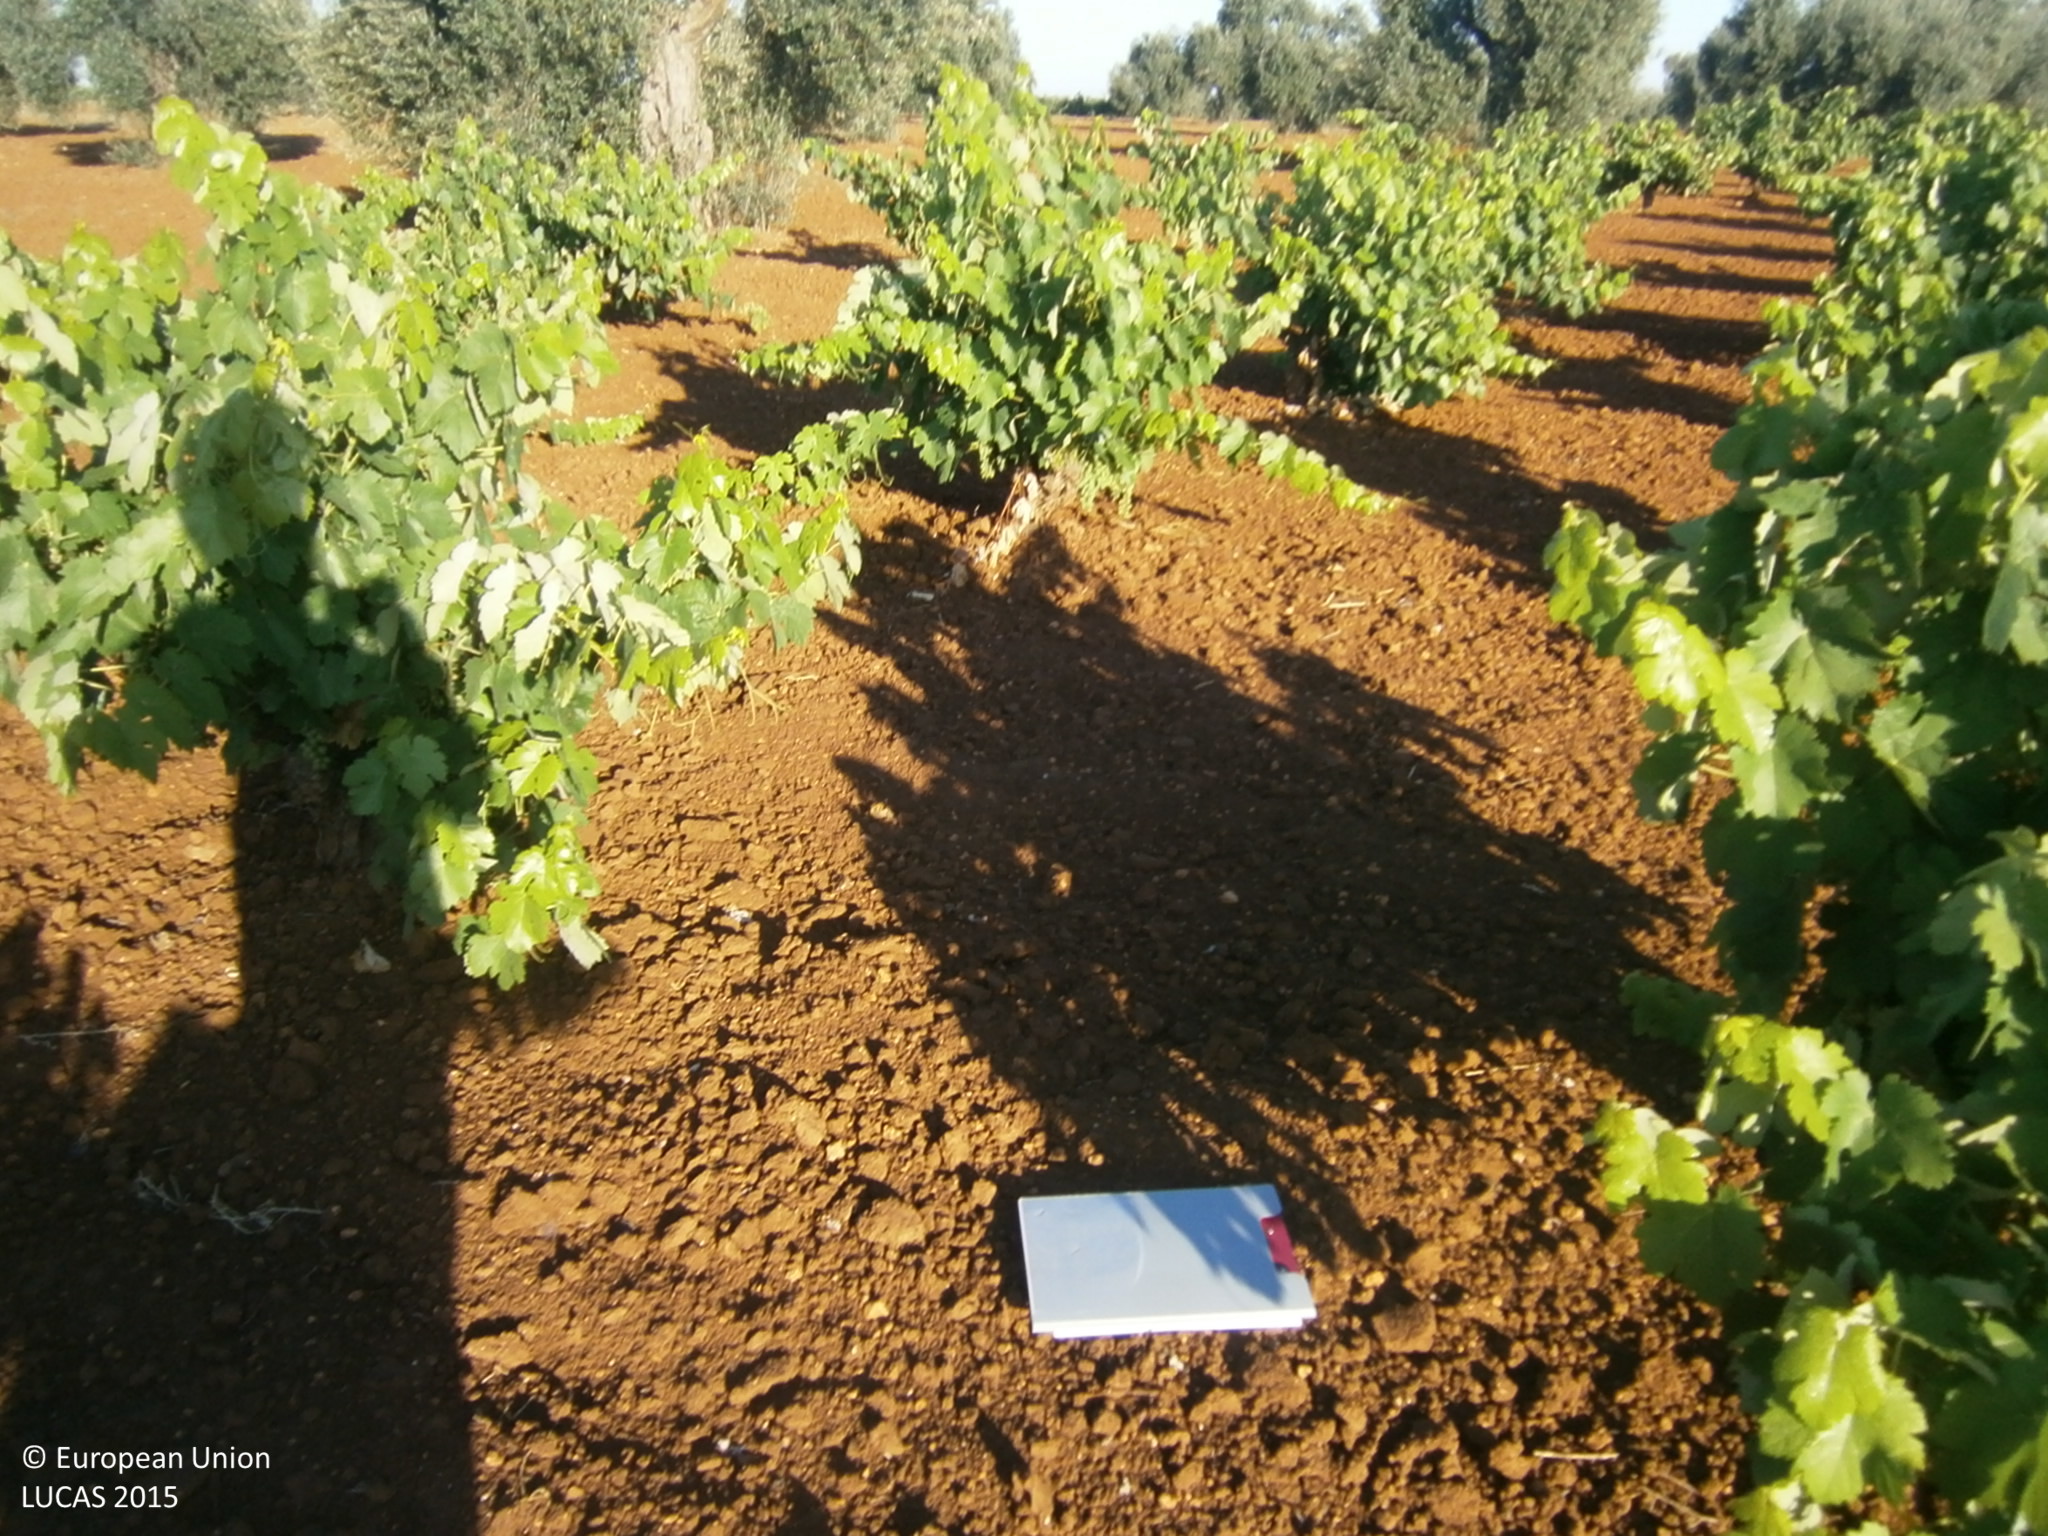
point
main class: Cropland
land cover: Vineyards
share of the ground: 25 - 50 %
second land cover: Other bare soil
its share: > 75 %
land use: Agriculture (excluding fallow land and kitchen gardens)
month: June
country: ES
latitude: 38.7566
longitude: -6.4550
